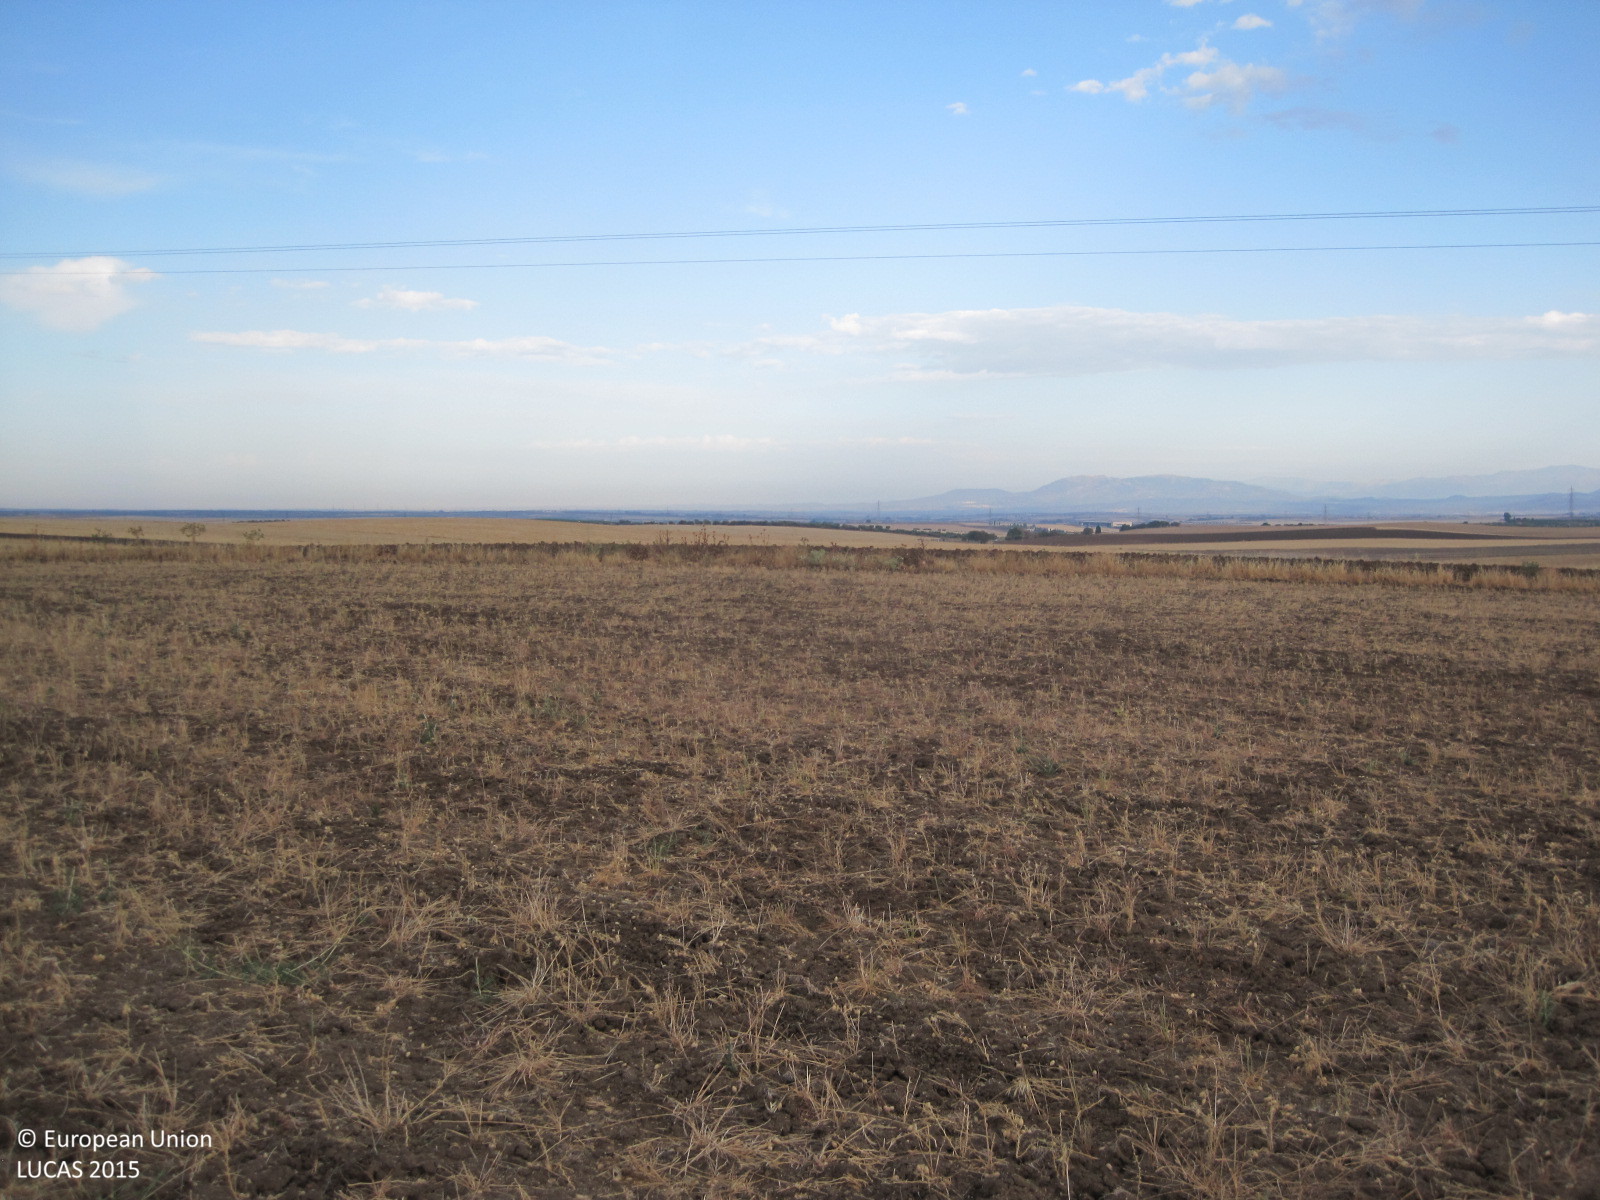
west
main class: Cropland
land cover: Dry pulses
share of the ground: < 10 %
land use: Agriculture (excluding fallow land and kitchen gardens)
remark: Harvested field
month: July
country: ES
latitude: 40.0420
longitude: -4.2809
